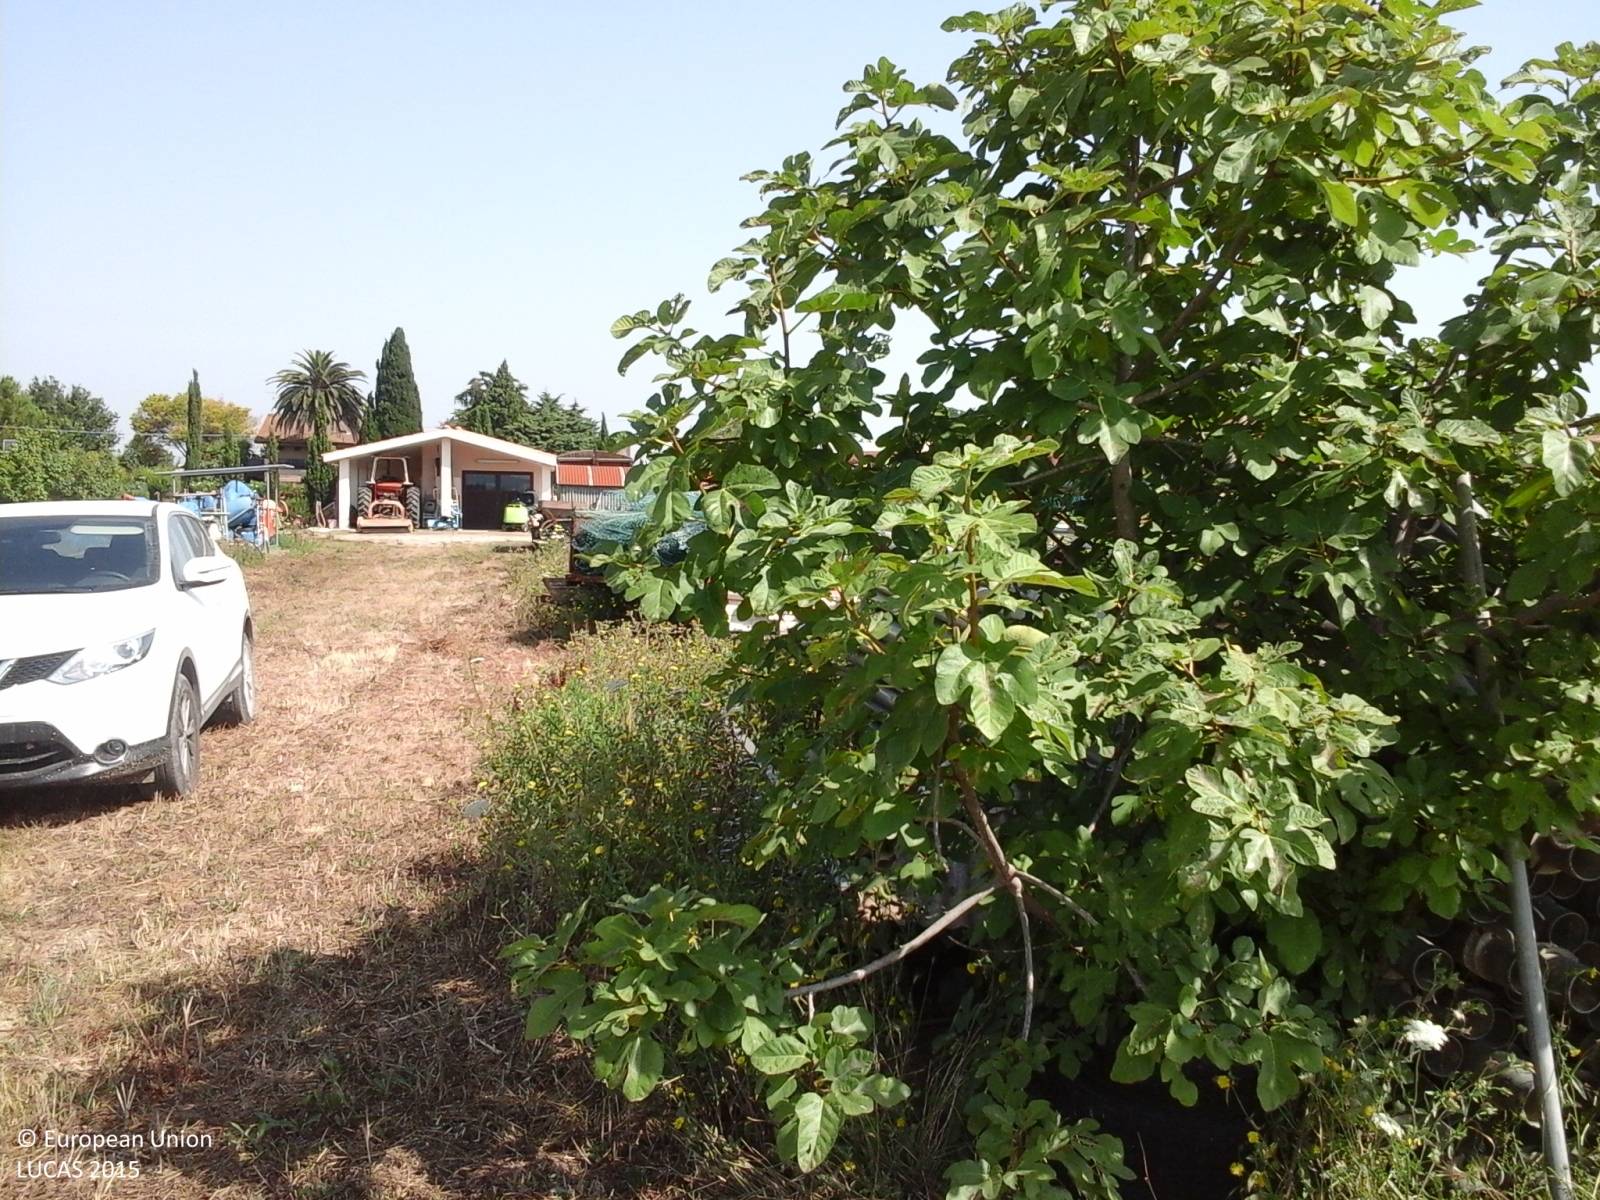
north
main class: Cropland
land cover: Barley
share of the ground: > 75 %
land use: Agriculture (excluding fallow land and kitchen gardens)
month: July
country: IT
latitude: 42.7210
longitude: 11.0346
